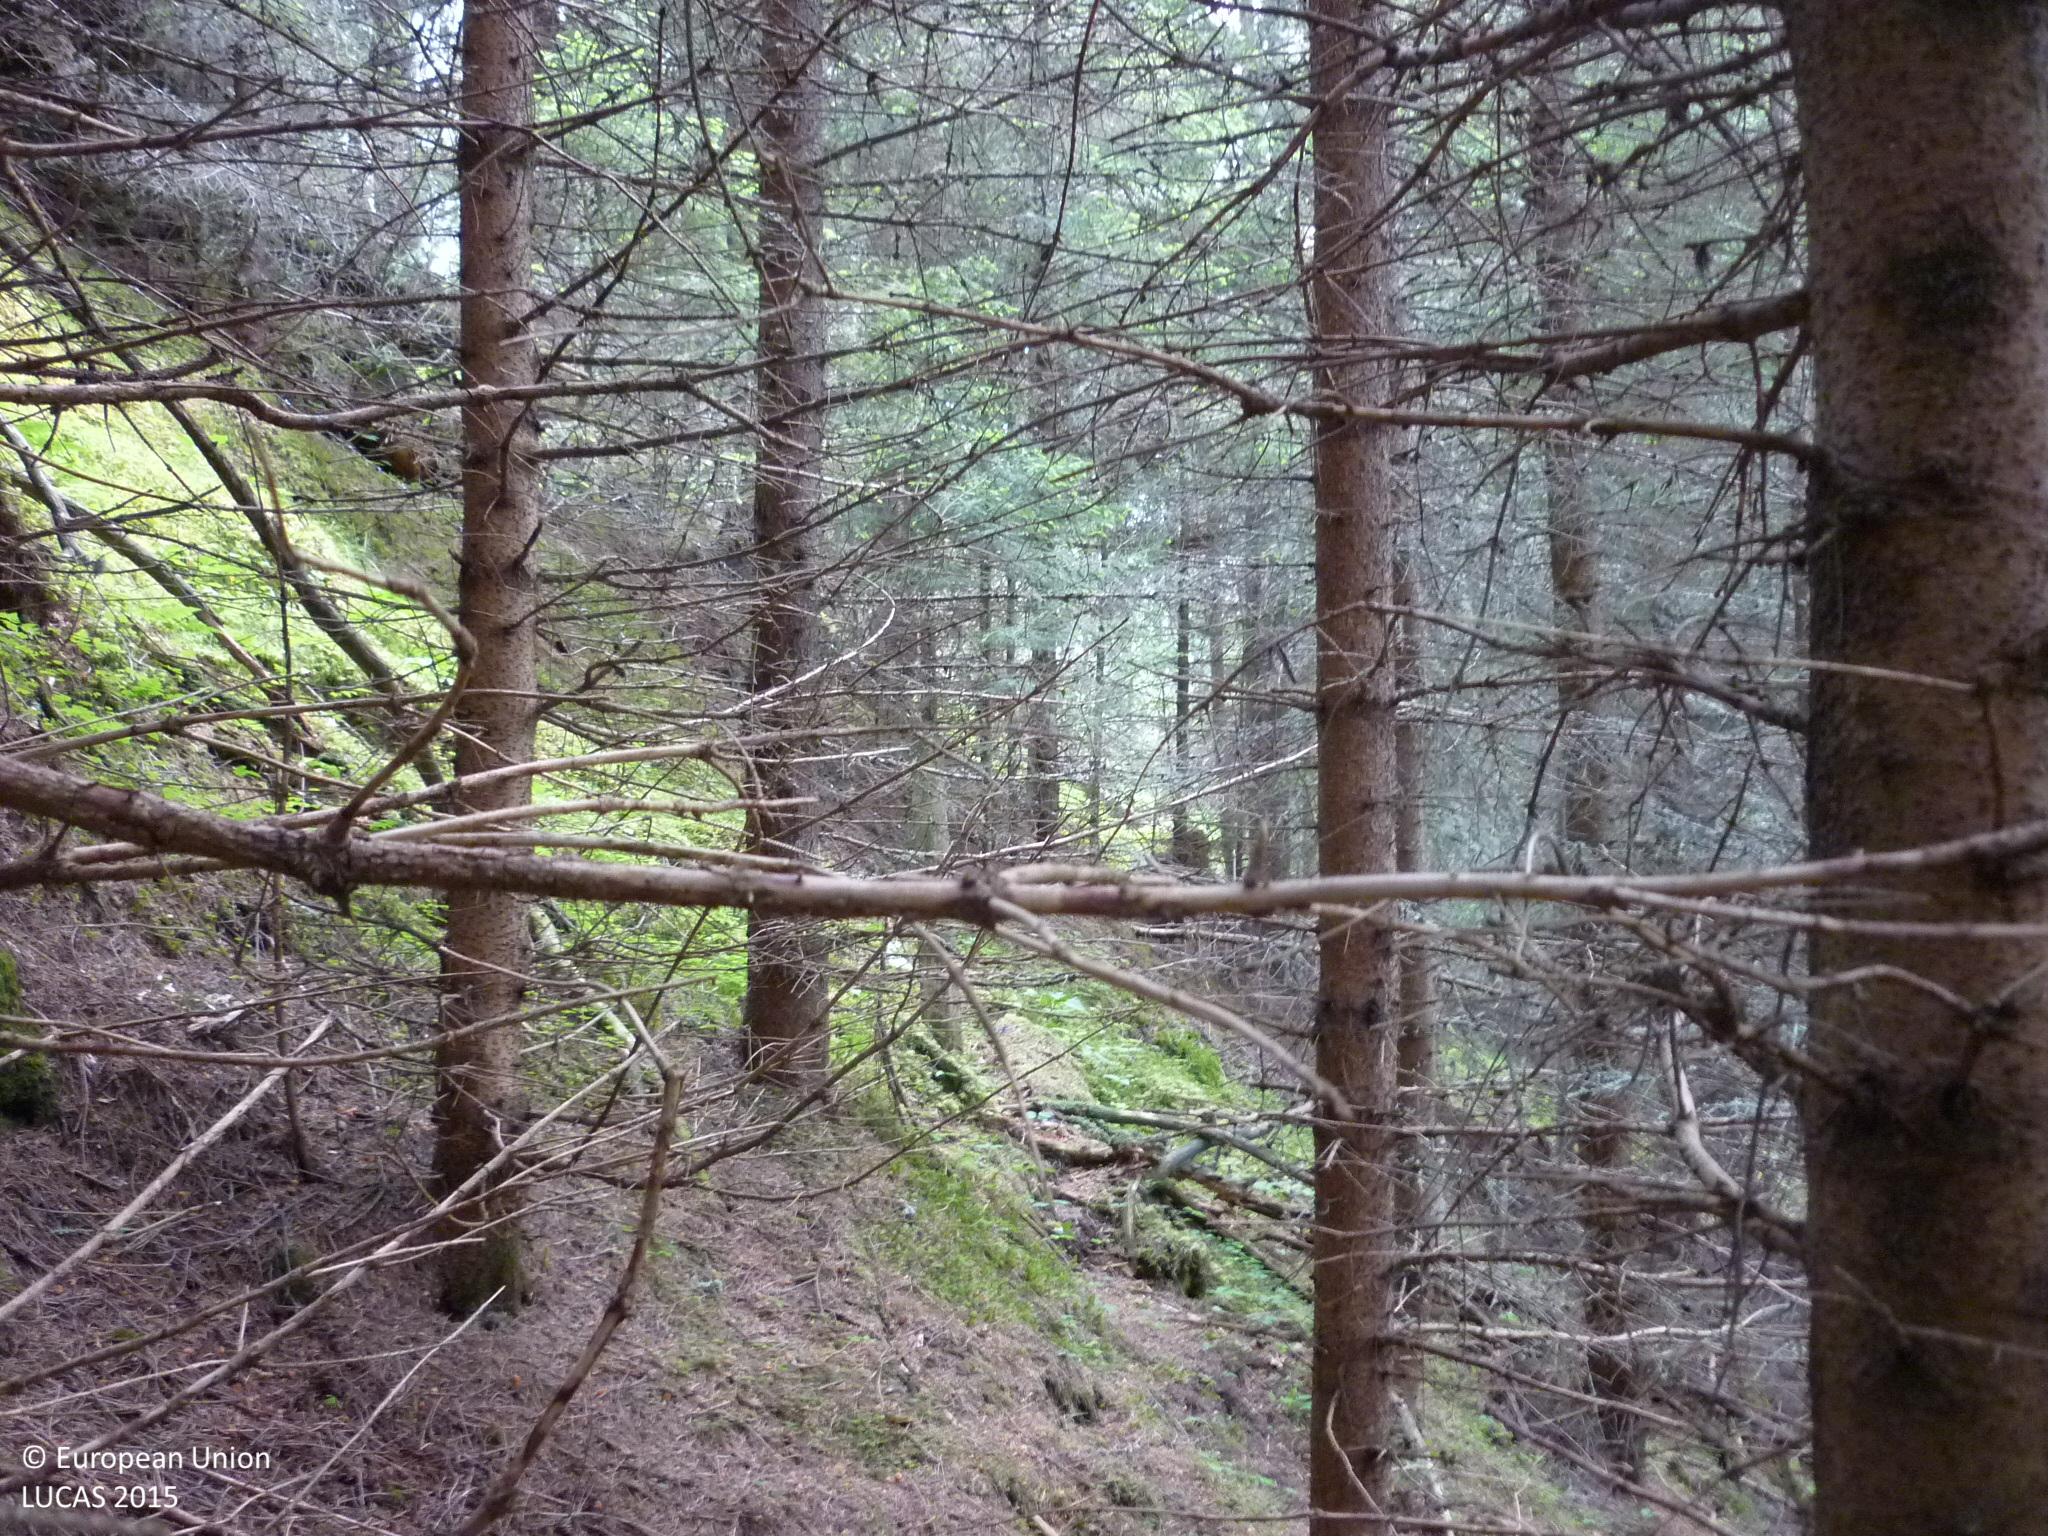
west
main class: Woodland
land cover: Spruce dominated coniferous woodland
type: alpine coniferous forest
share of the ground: > 75 %
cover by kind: coniferous forest trees 100 %
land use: Forestry
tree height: > 5 m
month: June
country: AT
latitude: 47.1721
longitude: 14.1542
